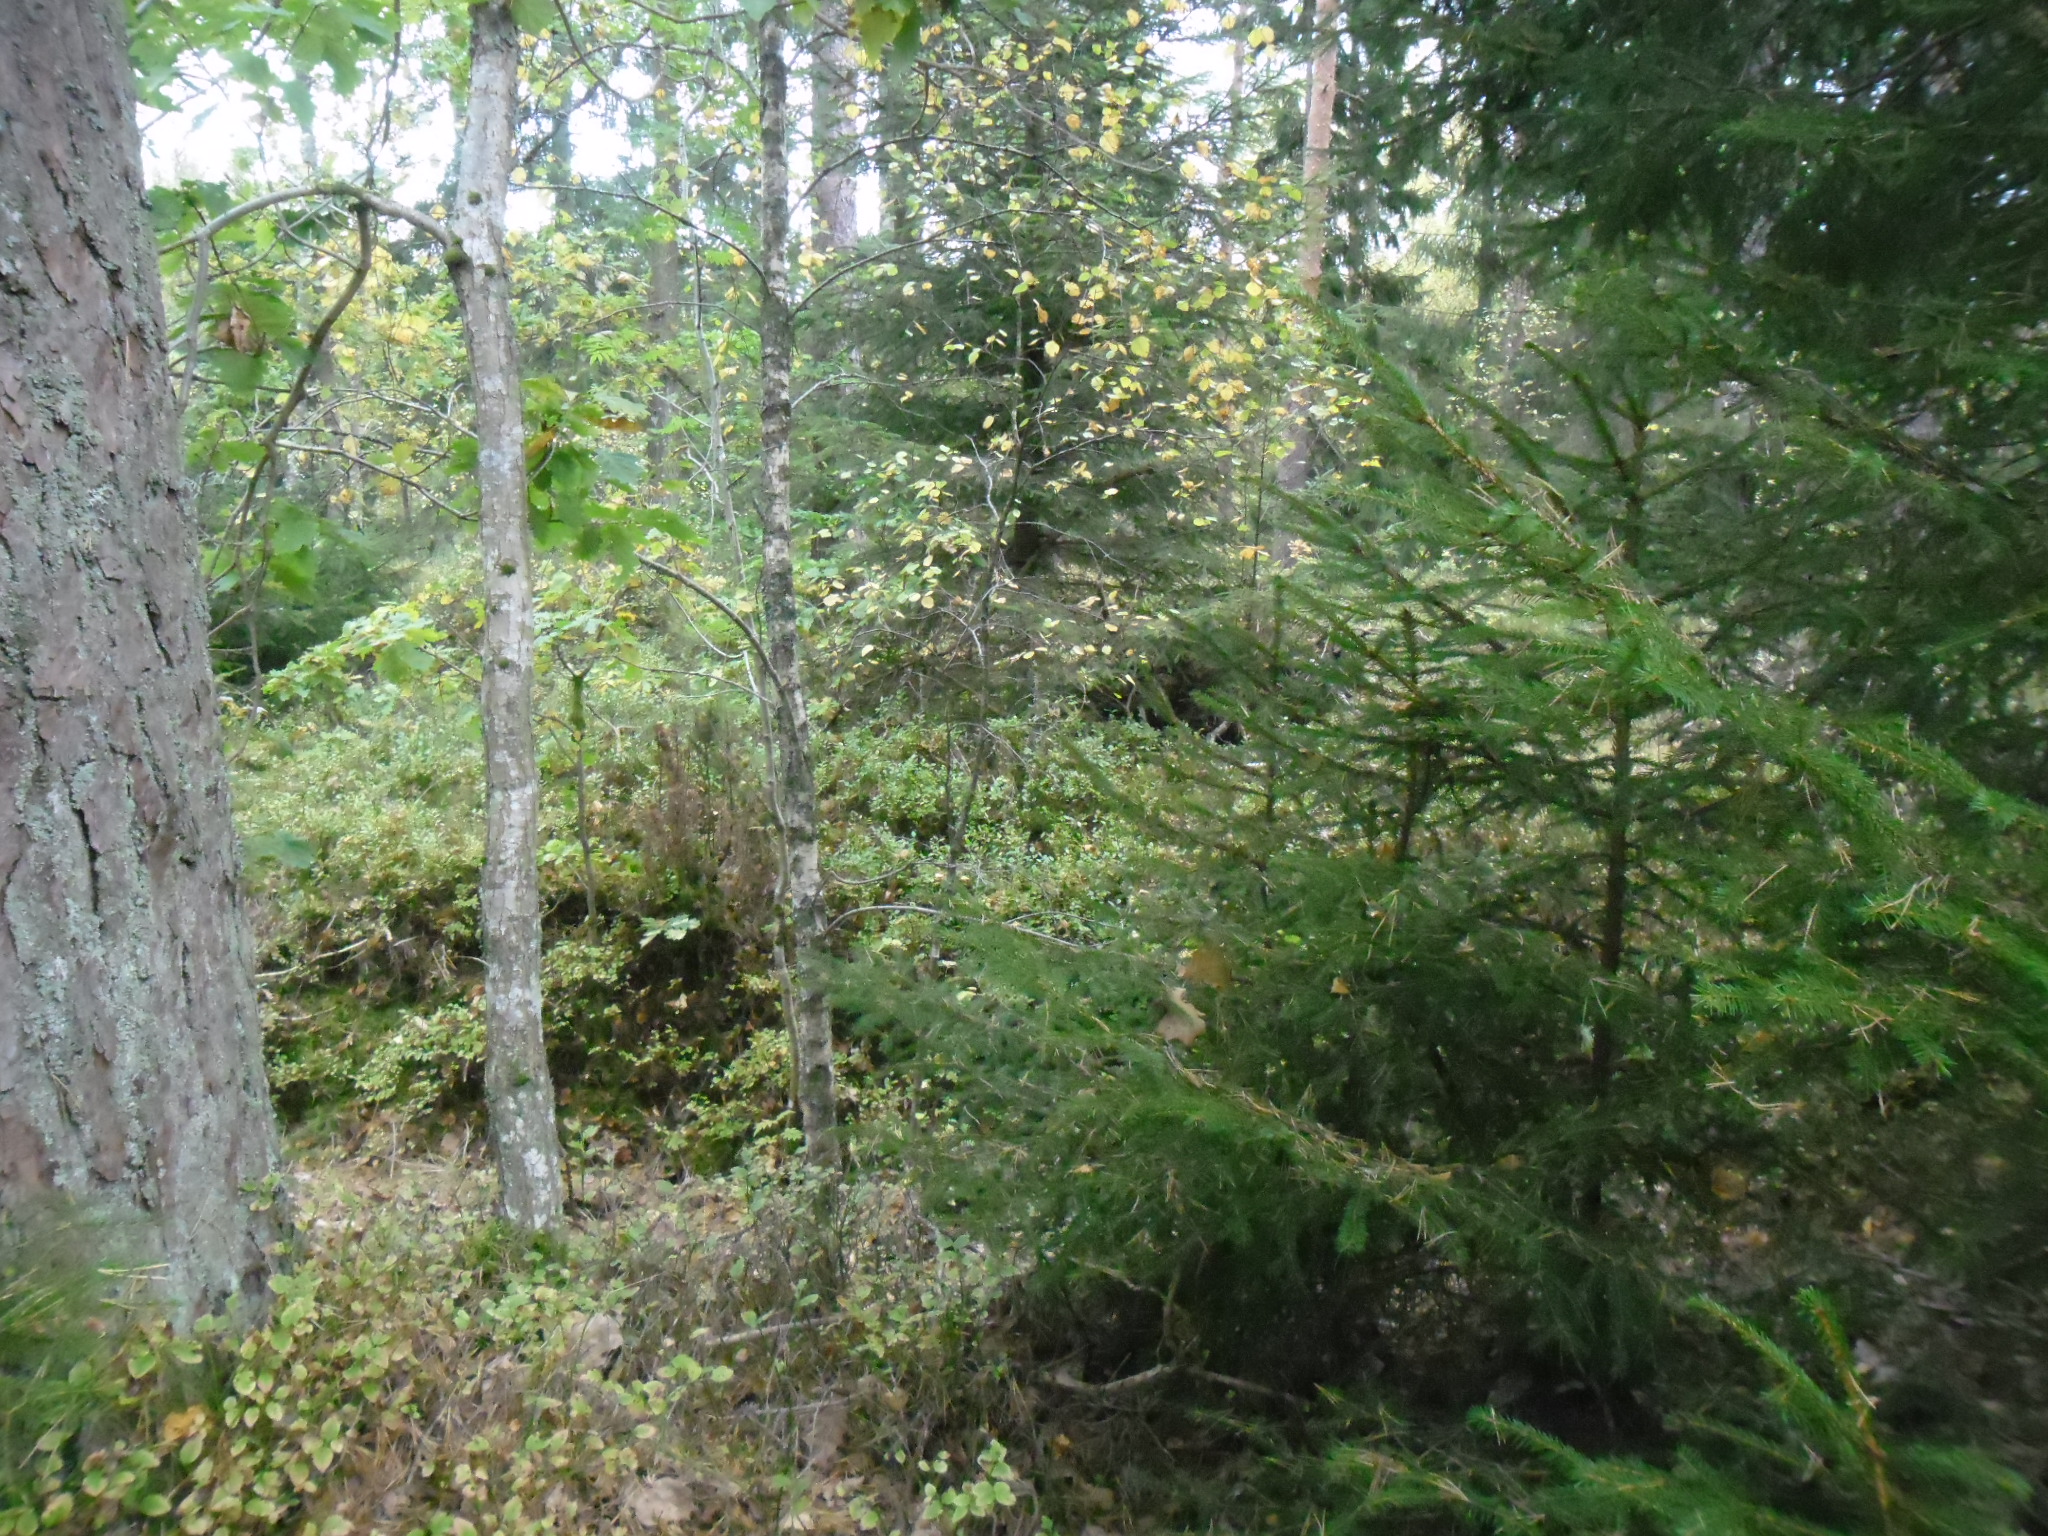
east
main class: Woodland
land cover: Spruce dominated mixed woodland
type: hemiboreal forest and nemoral coniferous forest and mixed broadleaved-coniferous forest
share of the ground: 50 - 75 %
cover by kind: coniferous forest trees 45 %, shrubs 30 %, broadleaved forest trees 15 %, herbaceous plants 10 %
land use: Forestry
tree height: > 5 m
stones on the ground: 25 - 50 %
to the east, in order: Spruce dominated mixed woodland; Tracks; Spruce dominated mixed woodland; Broadleaved woodland; Spruce dominated mixed woodland
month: October
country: SE
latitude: 56.3655
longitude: 13.8014
